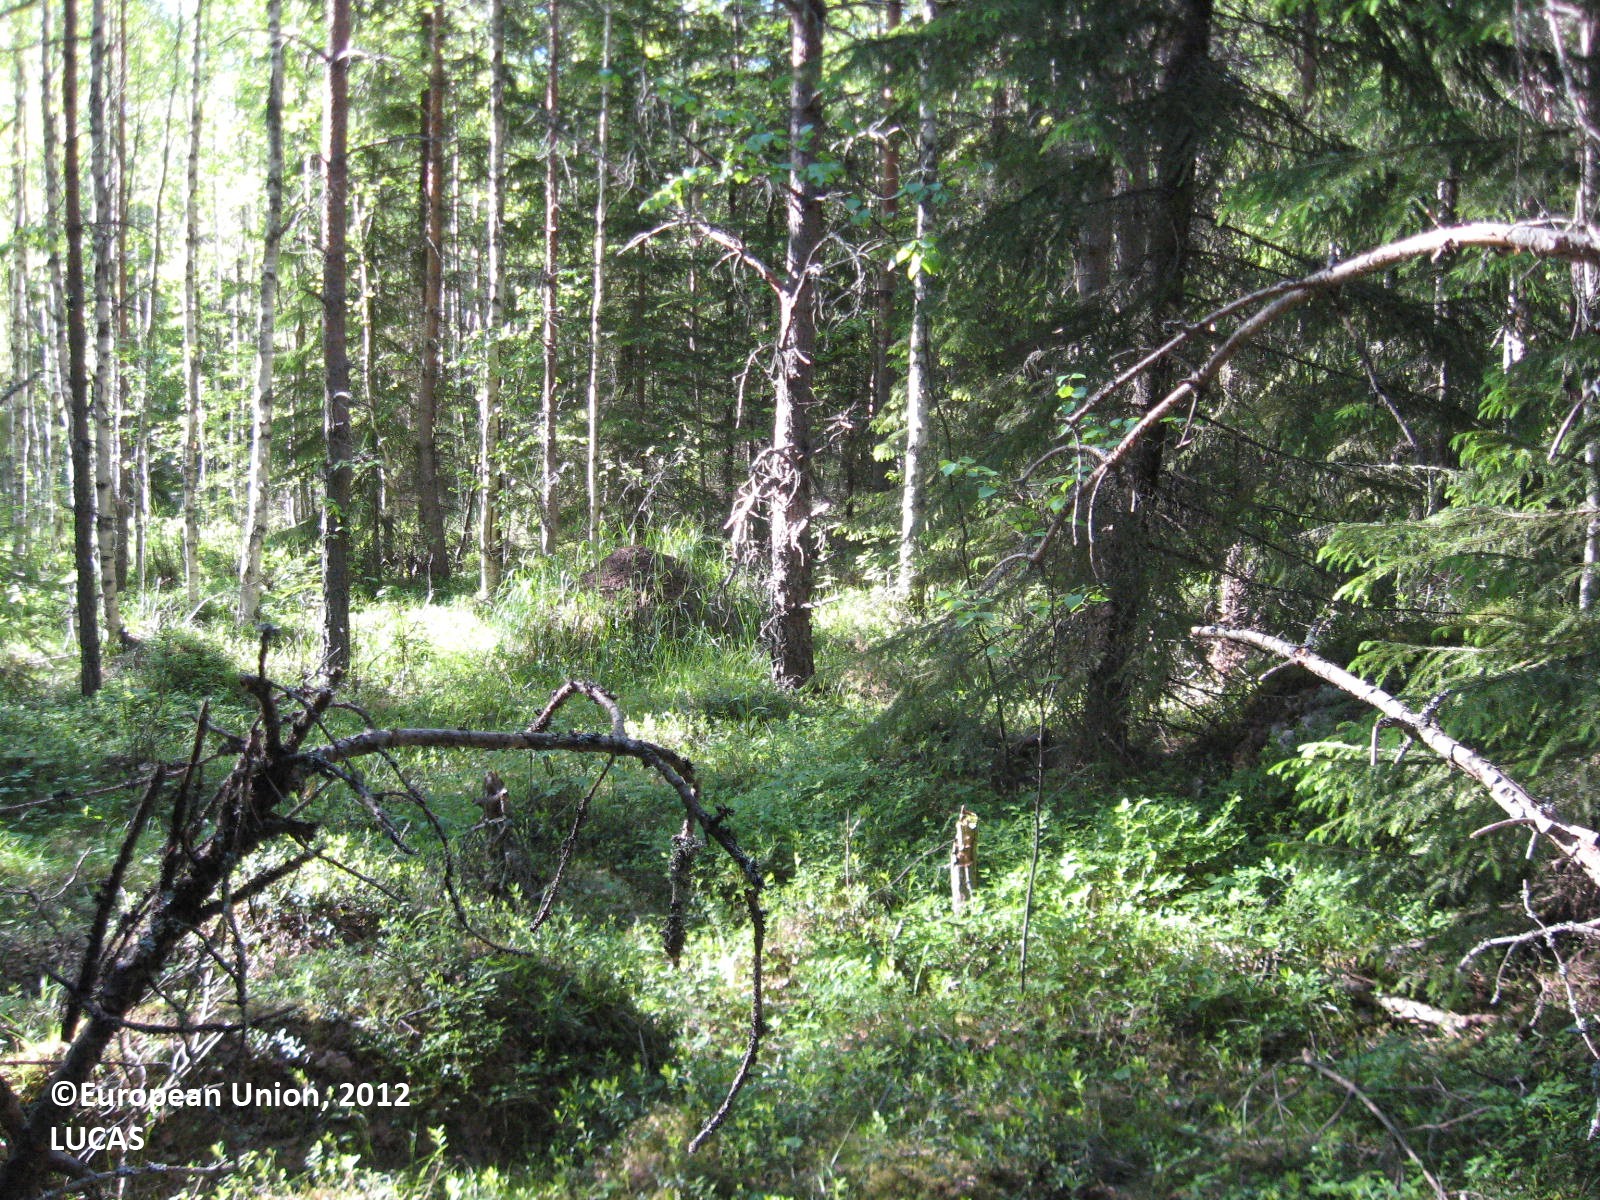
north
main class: Woodland
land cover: Spruce dominated mixed woodland
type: boreal forest
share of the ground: > 75 %
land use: Forestry
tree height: > 5 m
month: June
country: FI
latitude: 62.7490
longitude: 21.5724
